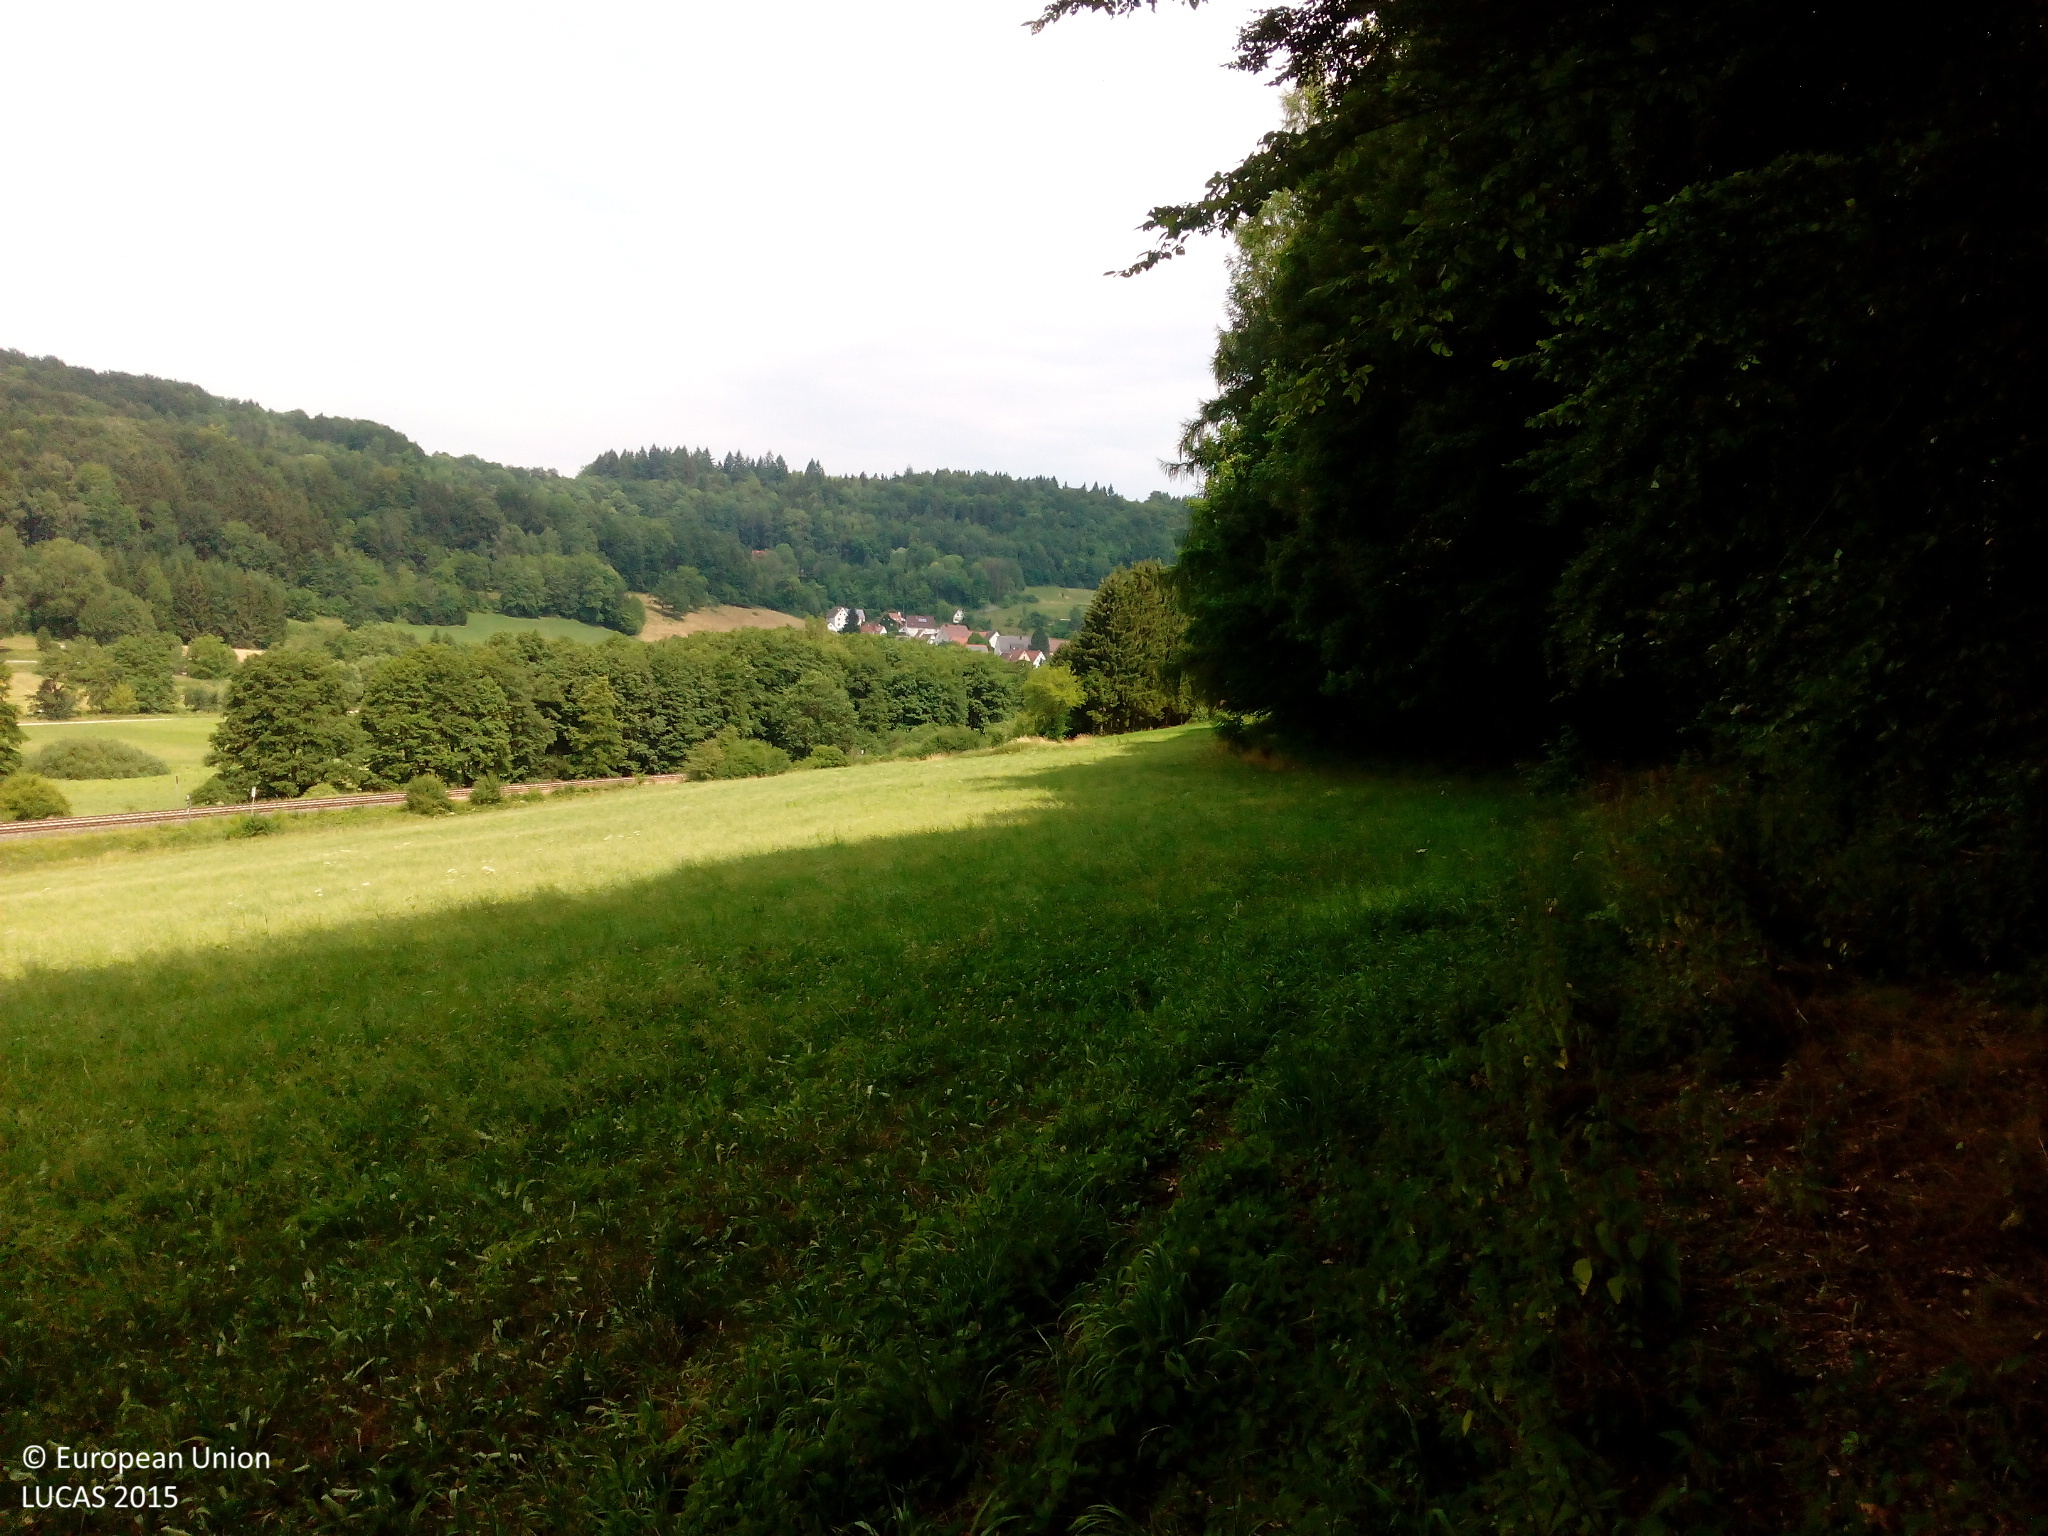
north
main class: Grassland
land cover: Grassland without tree/shrub cover
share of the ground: > 75 %
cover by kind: herbaceous plants 95 %, unconsolidated bare surface 5 %
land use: Agriculture (excluding fallow land and kitchen gardens)
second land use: Amenities, museums, leisure
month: July
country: DE
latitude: 49.5451
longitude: 11.4784
